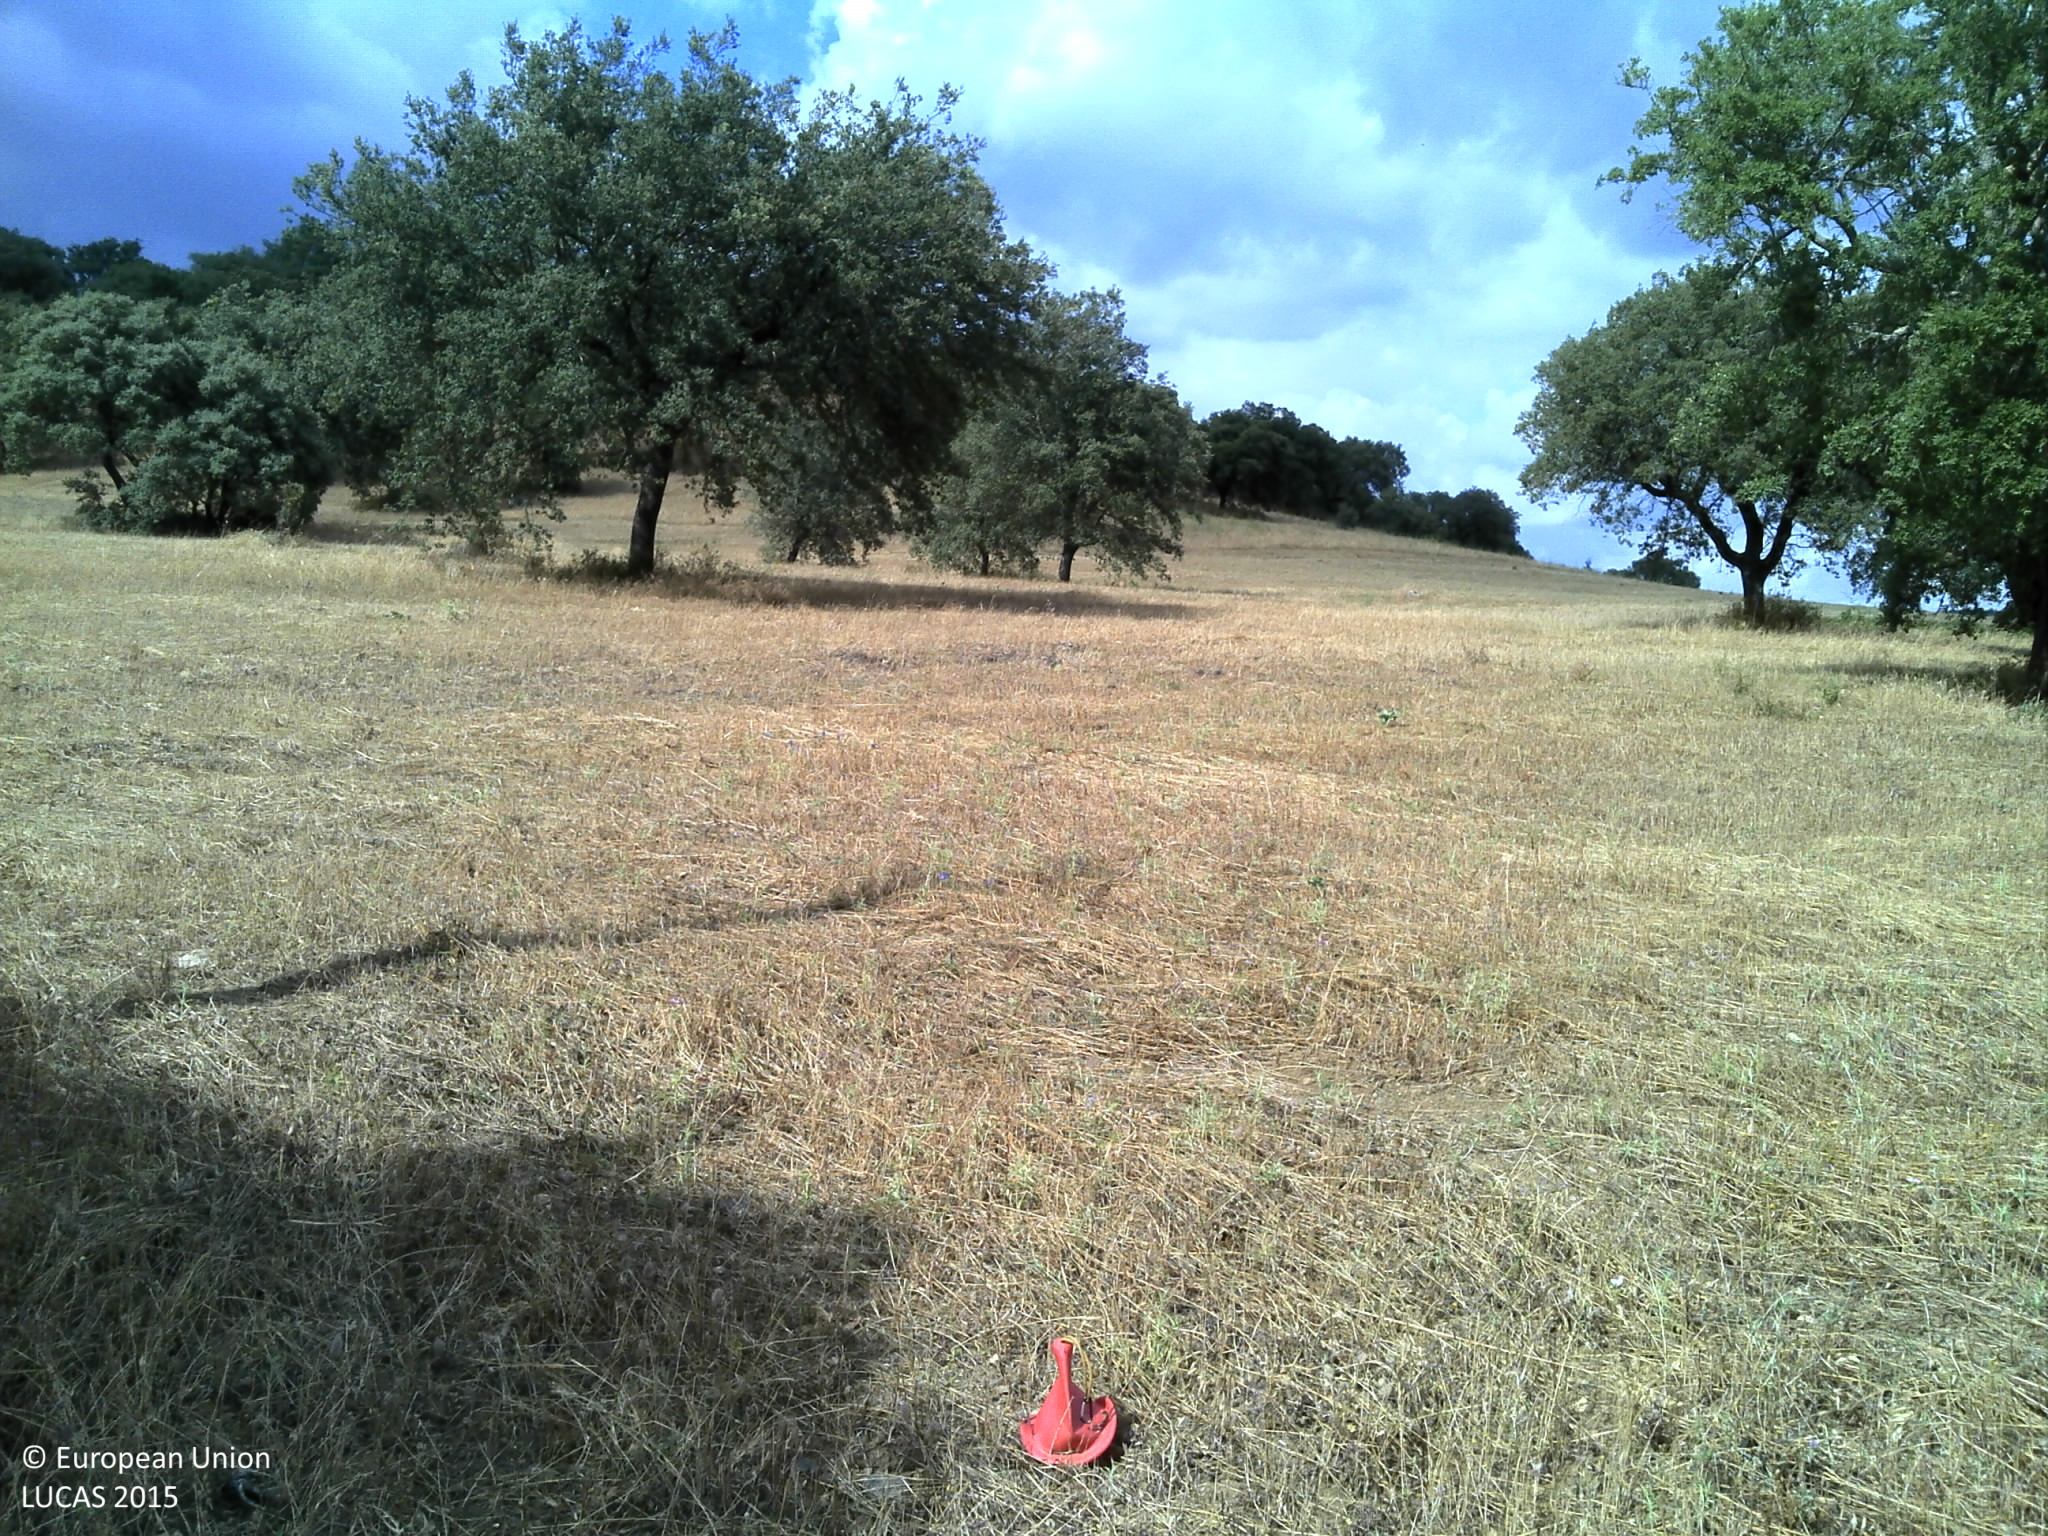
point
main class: Woodland
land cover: Broadleaved woodland
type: broadleaved evergreen forest
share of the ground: 10 - 25 %
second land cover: Other leguminous and mixtures for fodder
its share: < 10 %
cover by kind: unconsolidated bare surface 80 %, broadleaved forest trees 15 %, herbaceous plants 5 %
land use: Forestry
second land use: Agriculture (excluding fallow land and kitchen gardens)
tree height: > 5 m
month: June
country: PT
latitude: 38.5555
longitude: -8.1649
